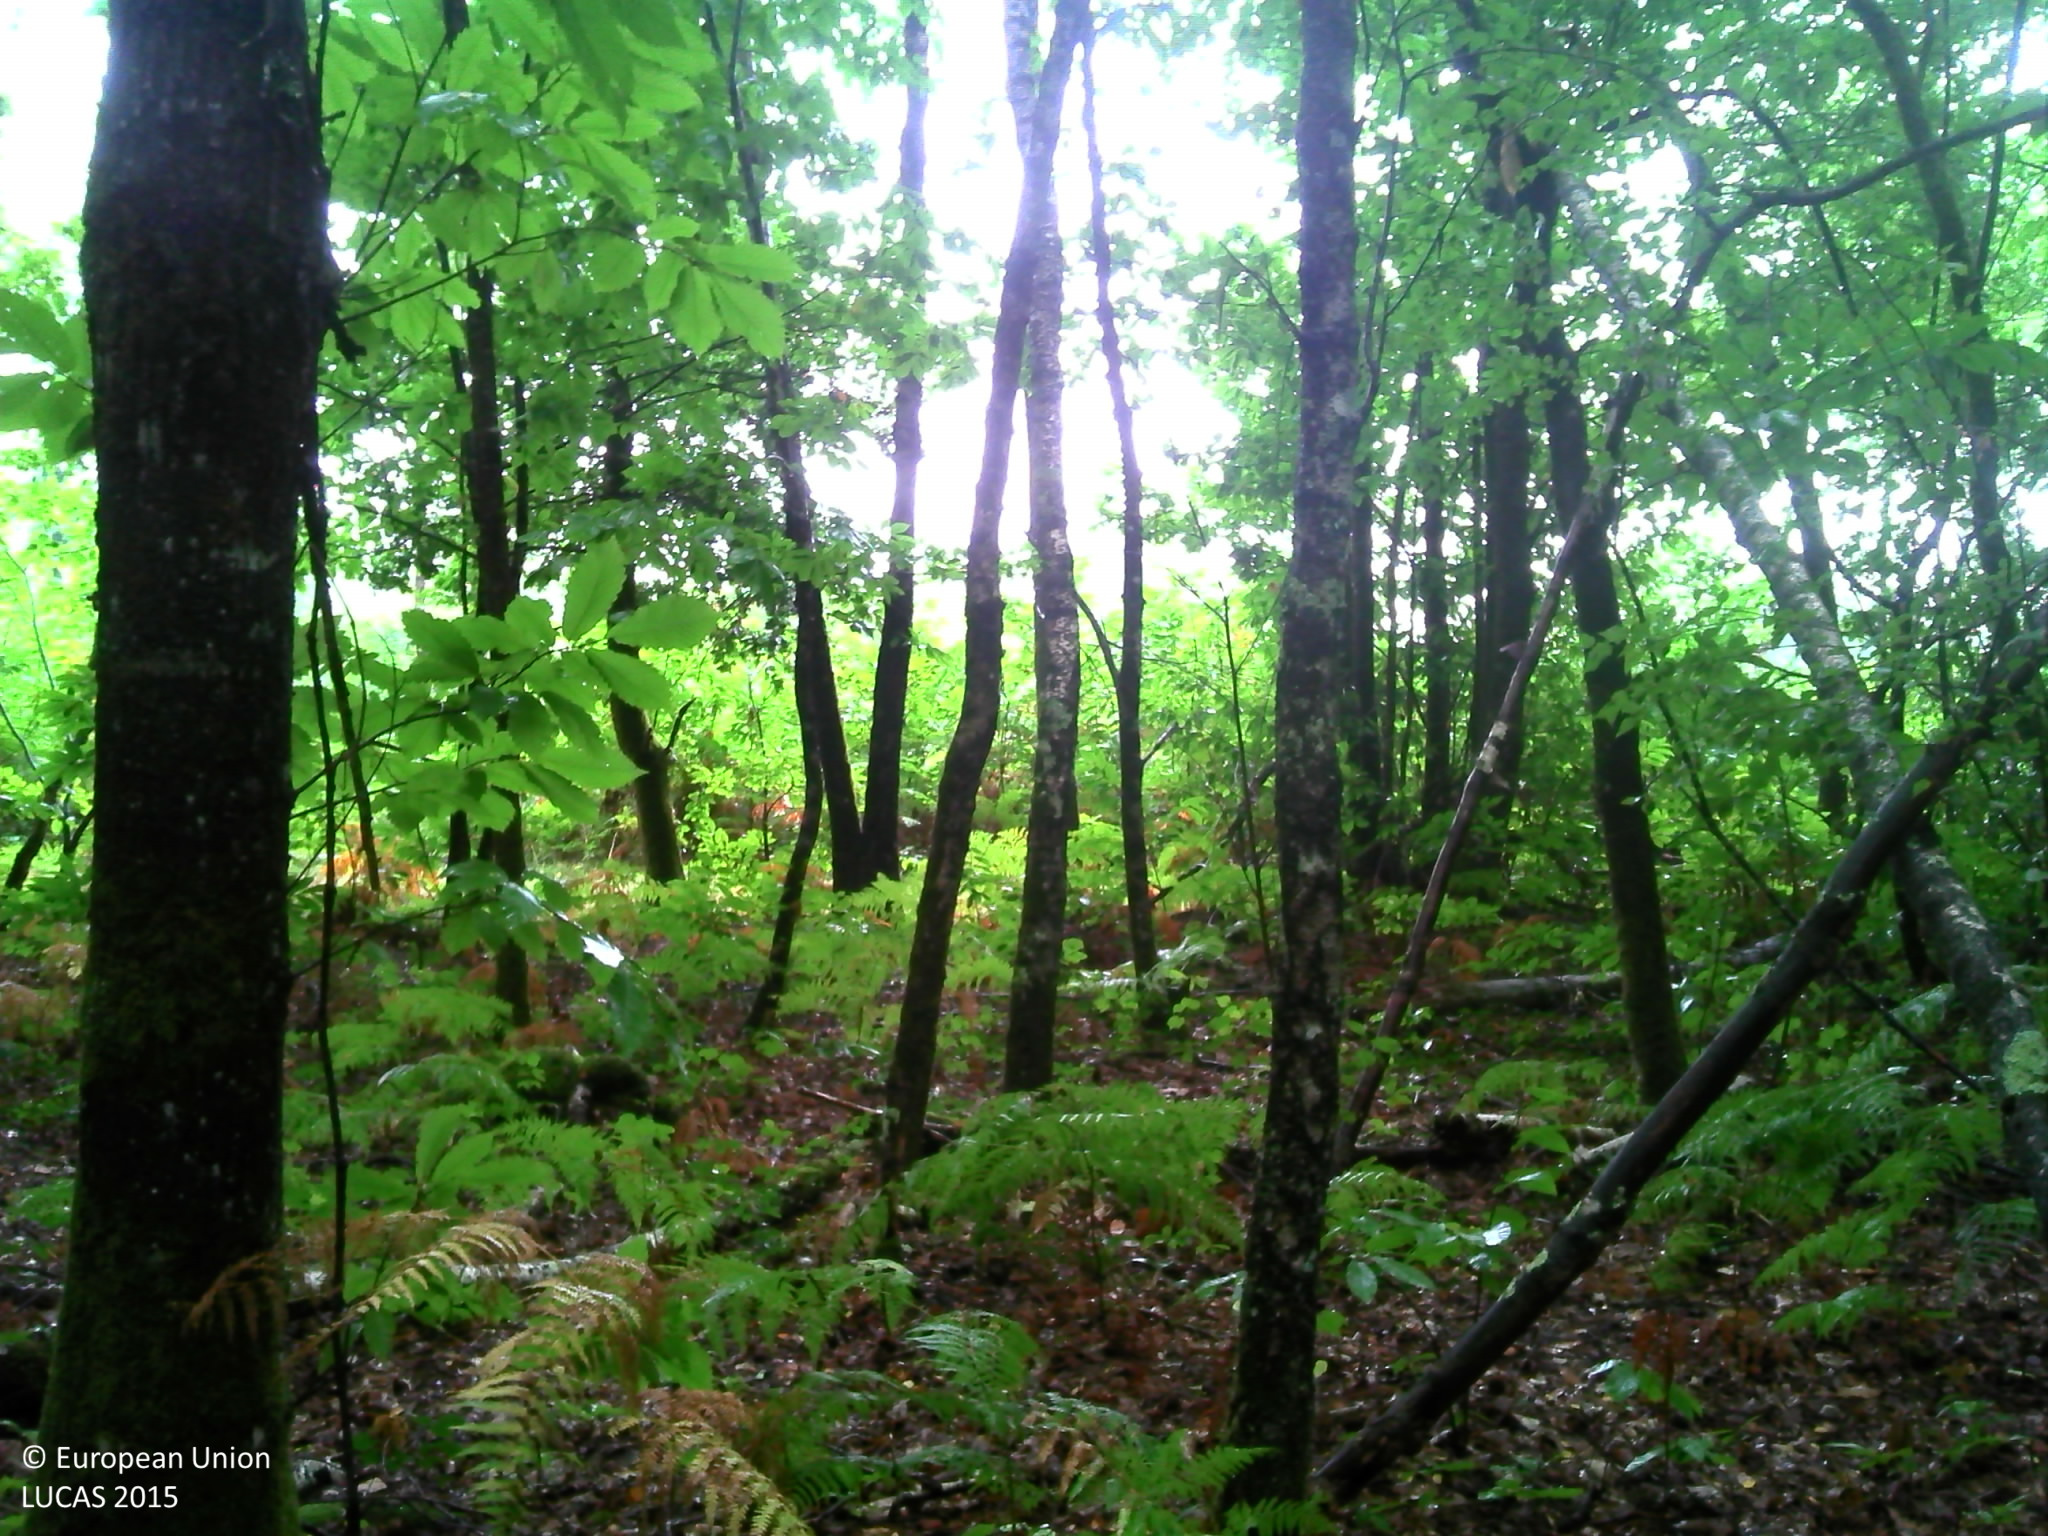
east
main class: Woodland
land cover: Broadleaved woodland
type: thermophilous deciduous forest
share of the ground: > 75 %
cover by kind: broadleaved forest trees 75 %, herbaceous plants 10 %, shrubs 5 %, lichens and mosses 5 %, consolidated bare surface 5 %
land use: Forestry
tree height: > 5 m
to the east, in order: Broadleaved woodland; Tracks; Broadleaved woodland; Grassland without tree/shrub cover; Broadleaved woodland; Fences; Grassland without tree/shrub cover; Broadleaved woodland
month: August
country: FR
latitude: 45.4684
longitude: 0.6383
